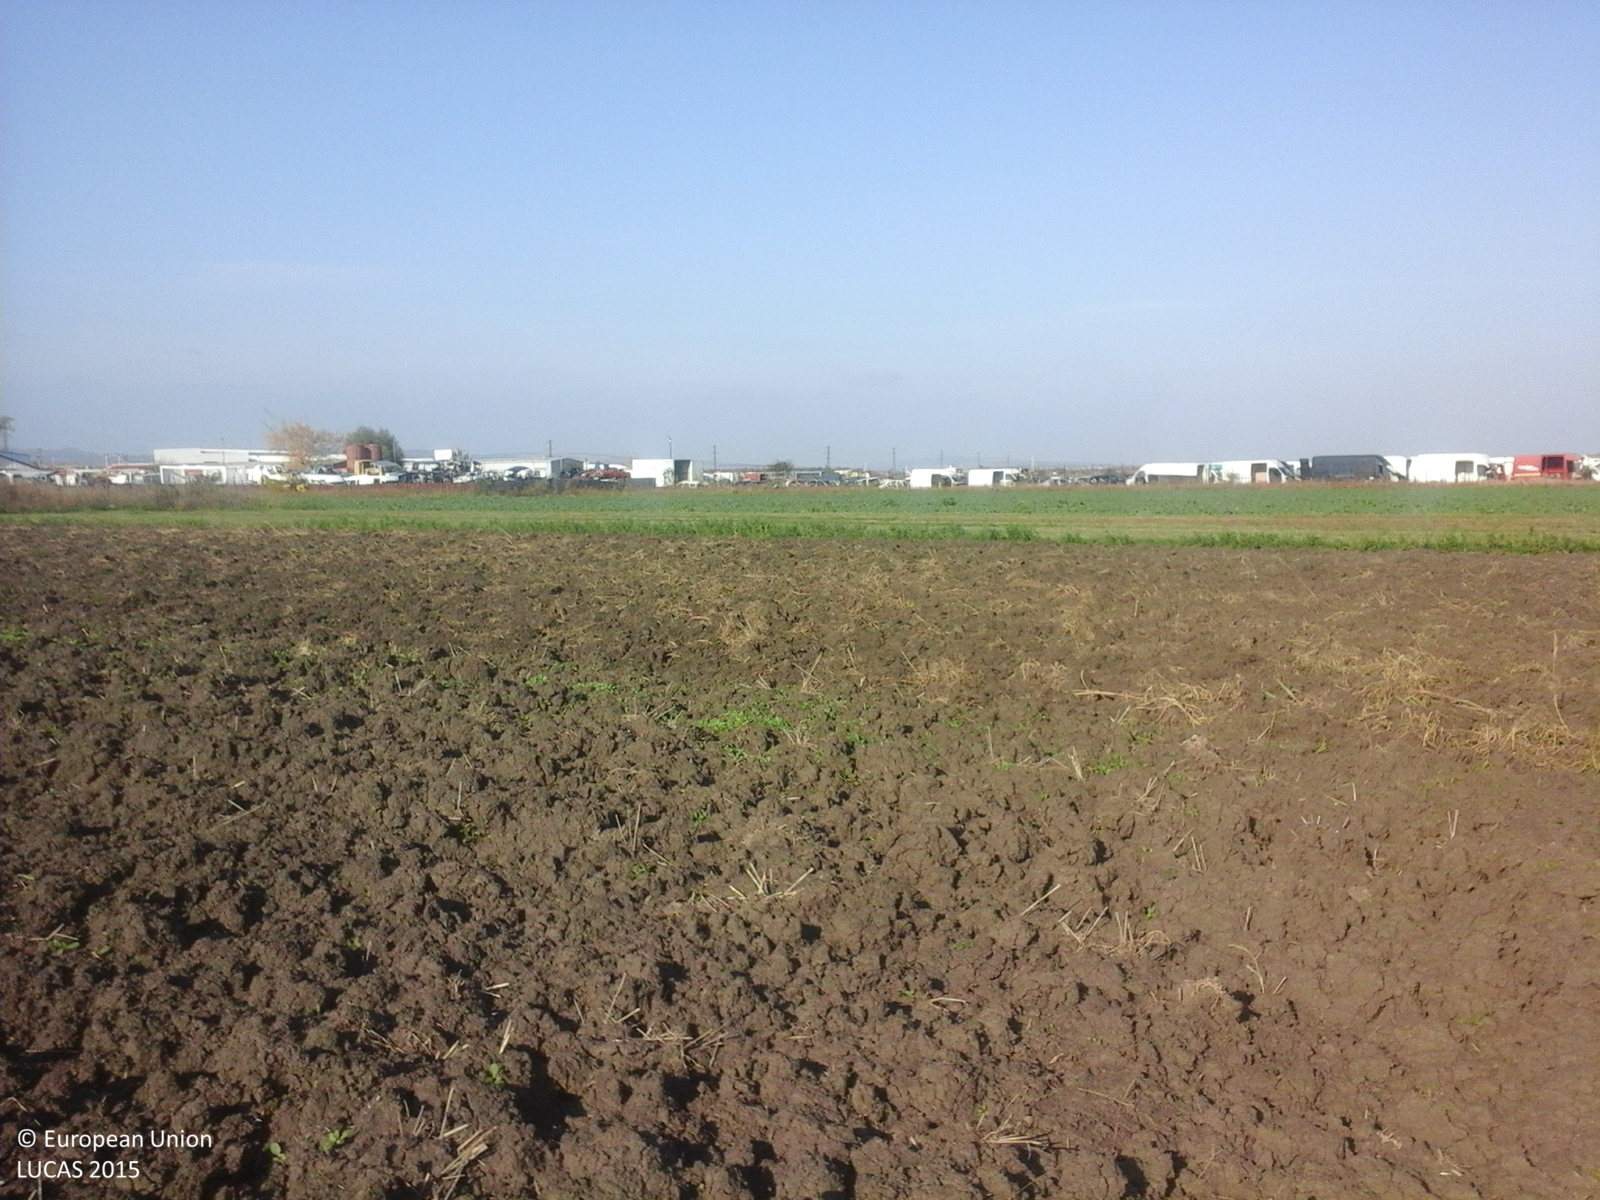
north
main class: Cropland
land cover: Common wheat
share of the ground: < 10 %
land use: Agriculture (excluding fallow land and kitchen gardens)
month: October
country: RO
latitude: 45.1871
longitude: 26.8427
